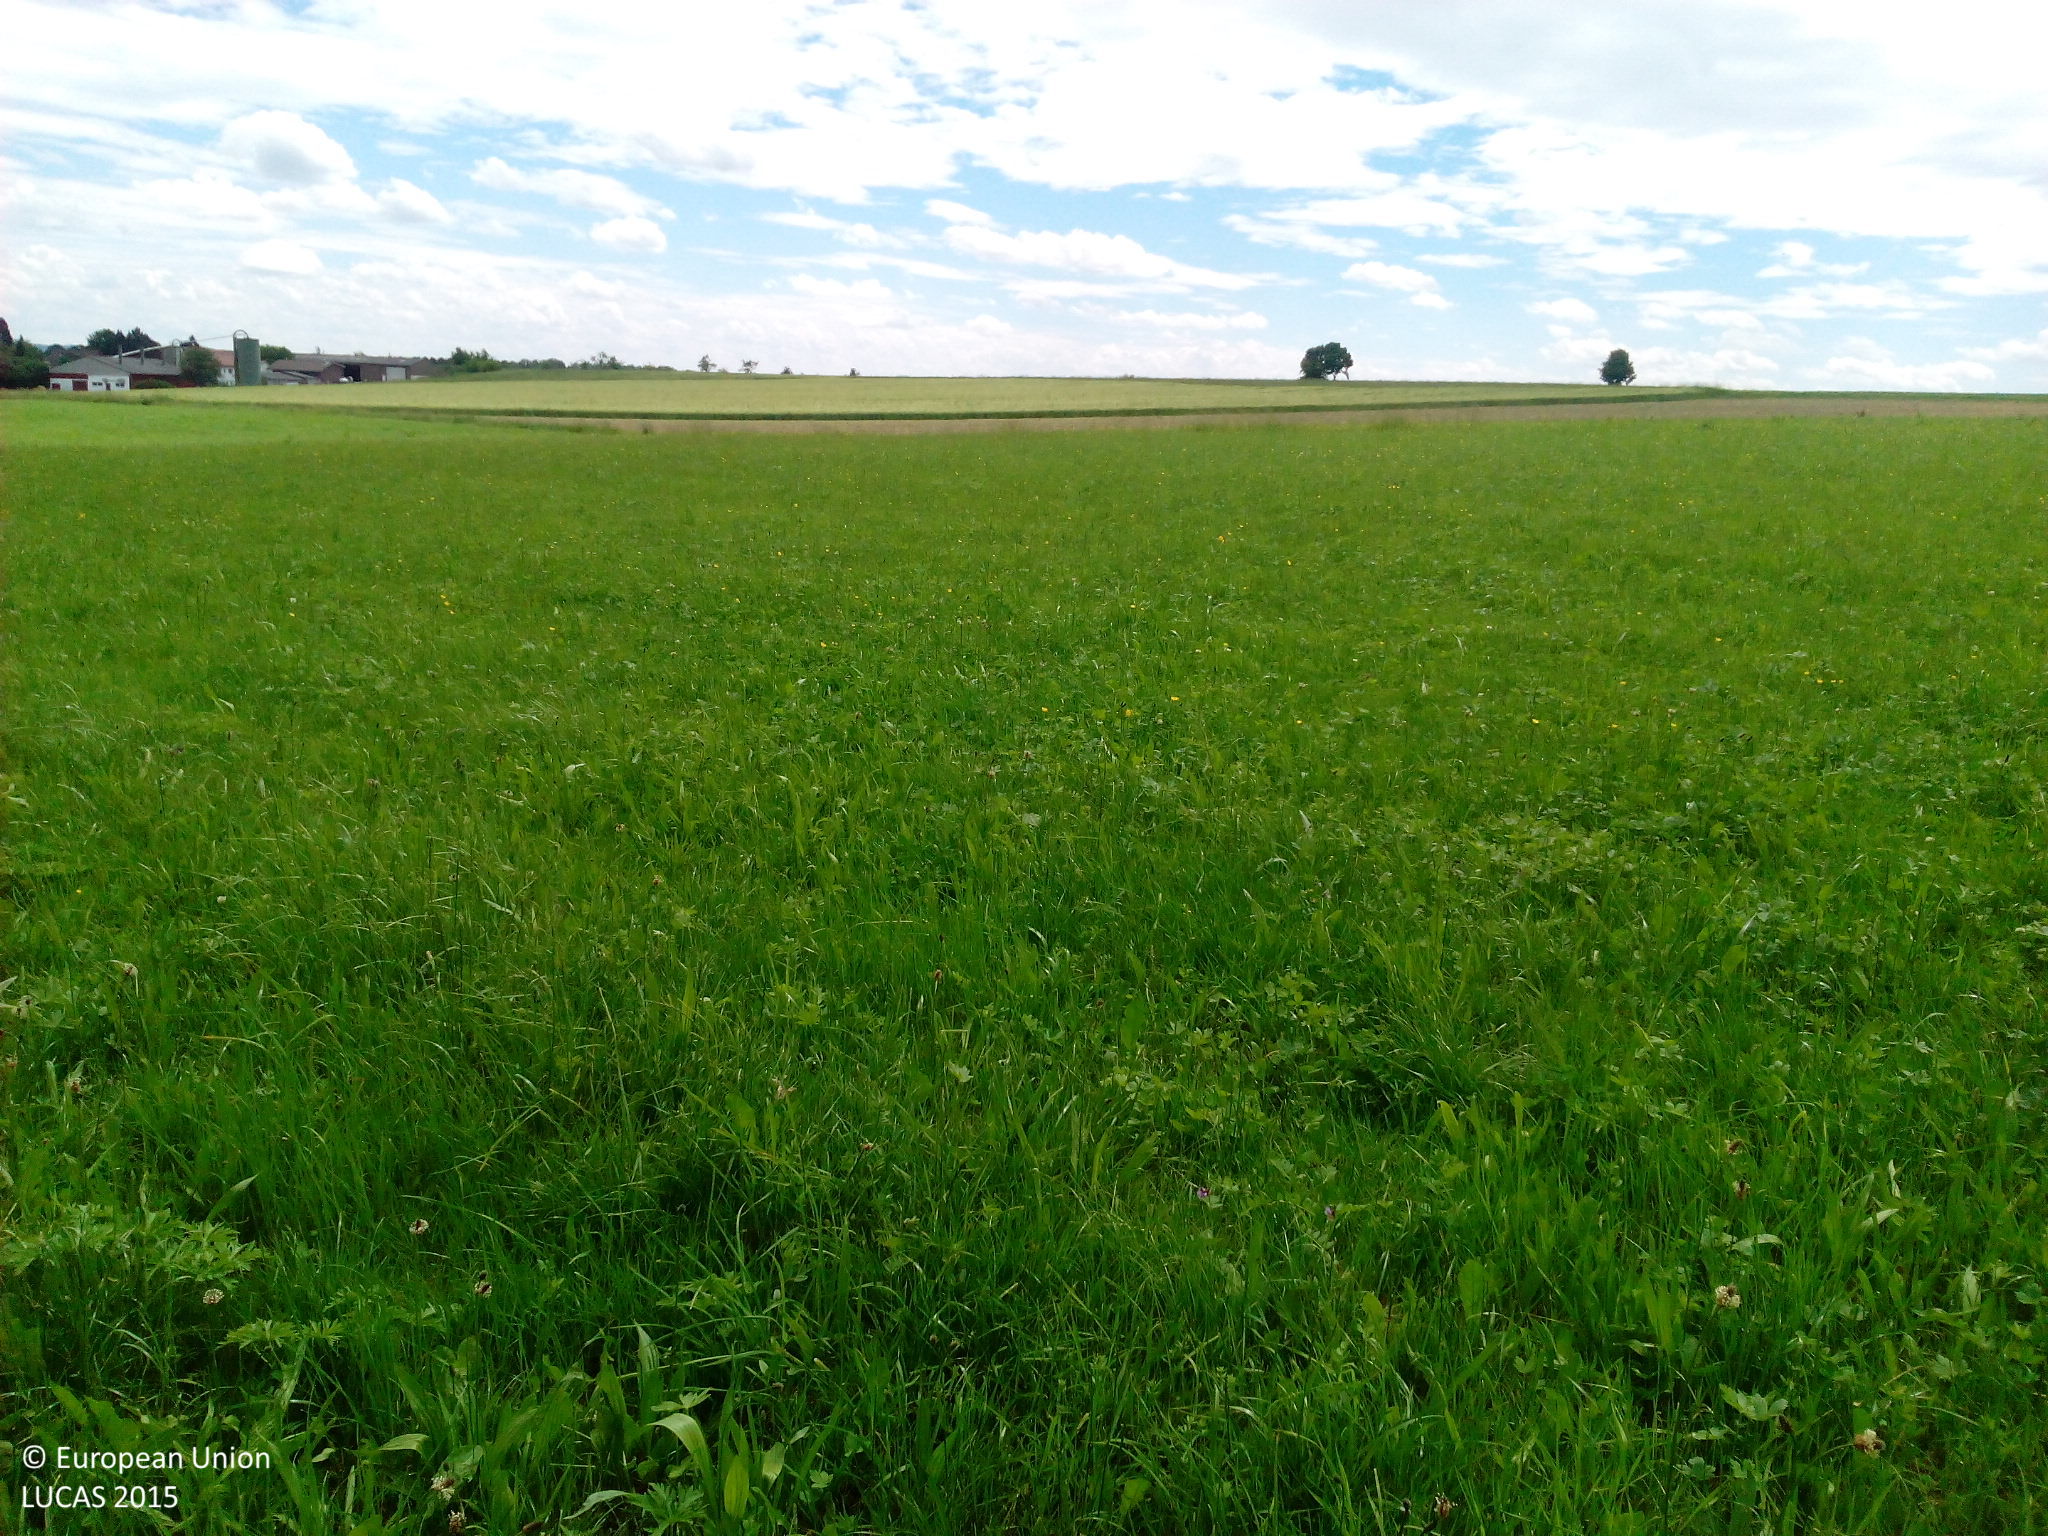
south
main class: Grassland
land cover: Grassland without tree/shrub cover
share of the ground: > 75 %
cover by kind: herbaceous plants 100 %
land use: Agriculture (excluding fallow land and kitchen gardens)
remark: Harvested field
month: June
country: DE
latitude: 48.9955
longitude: 9.3852
